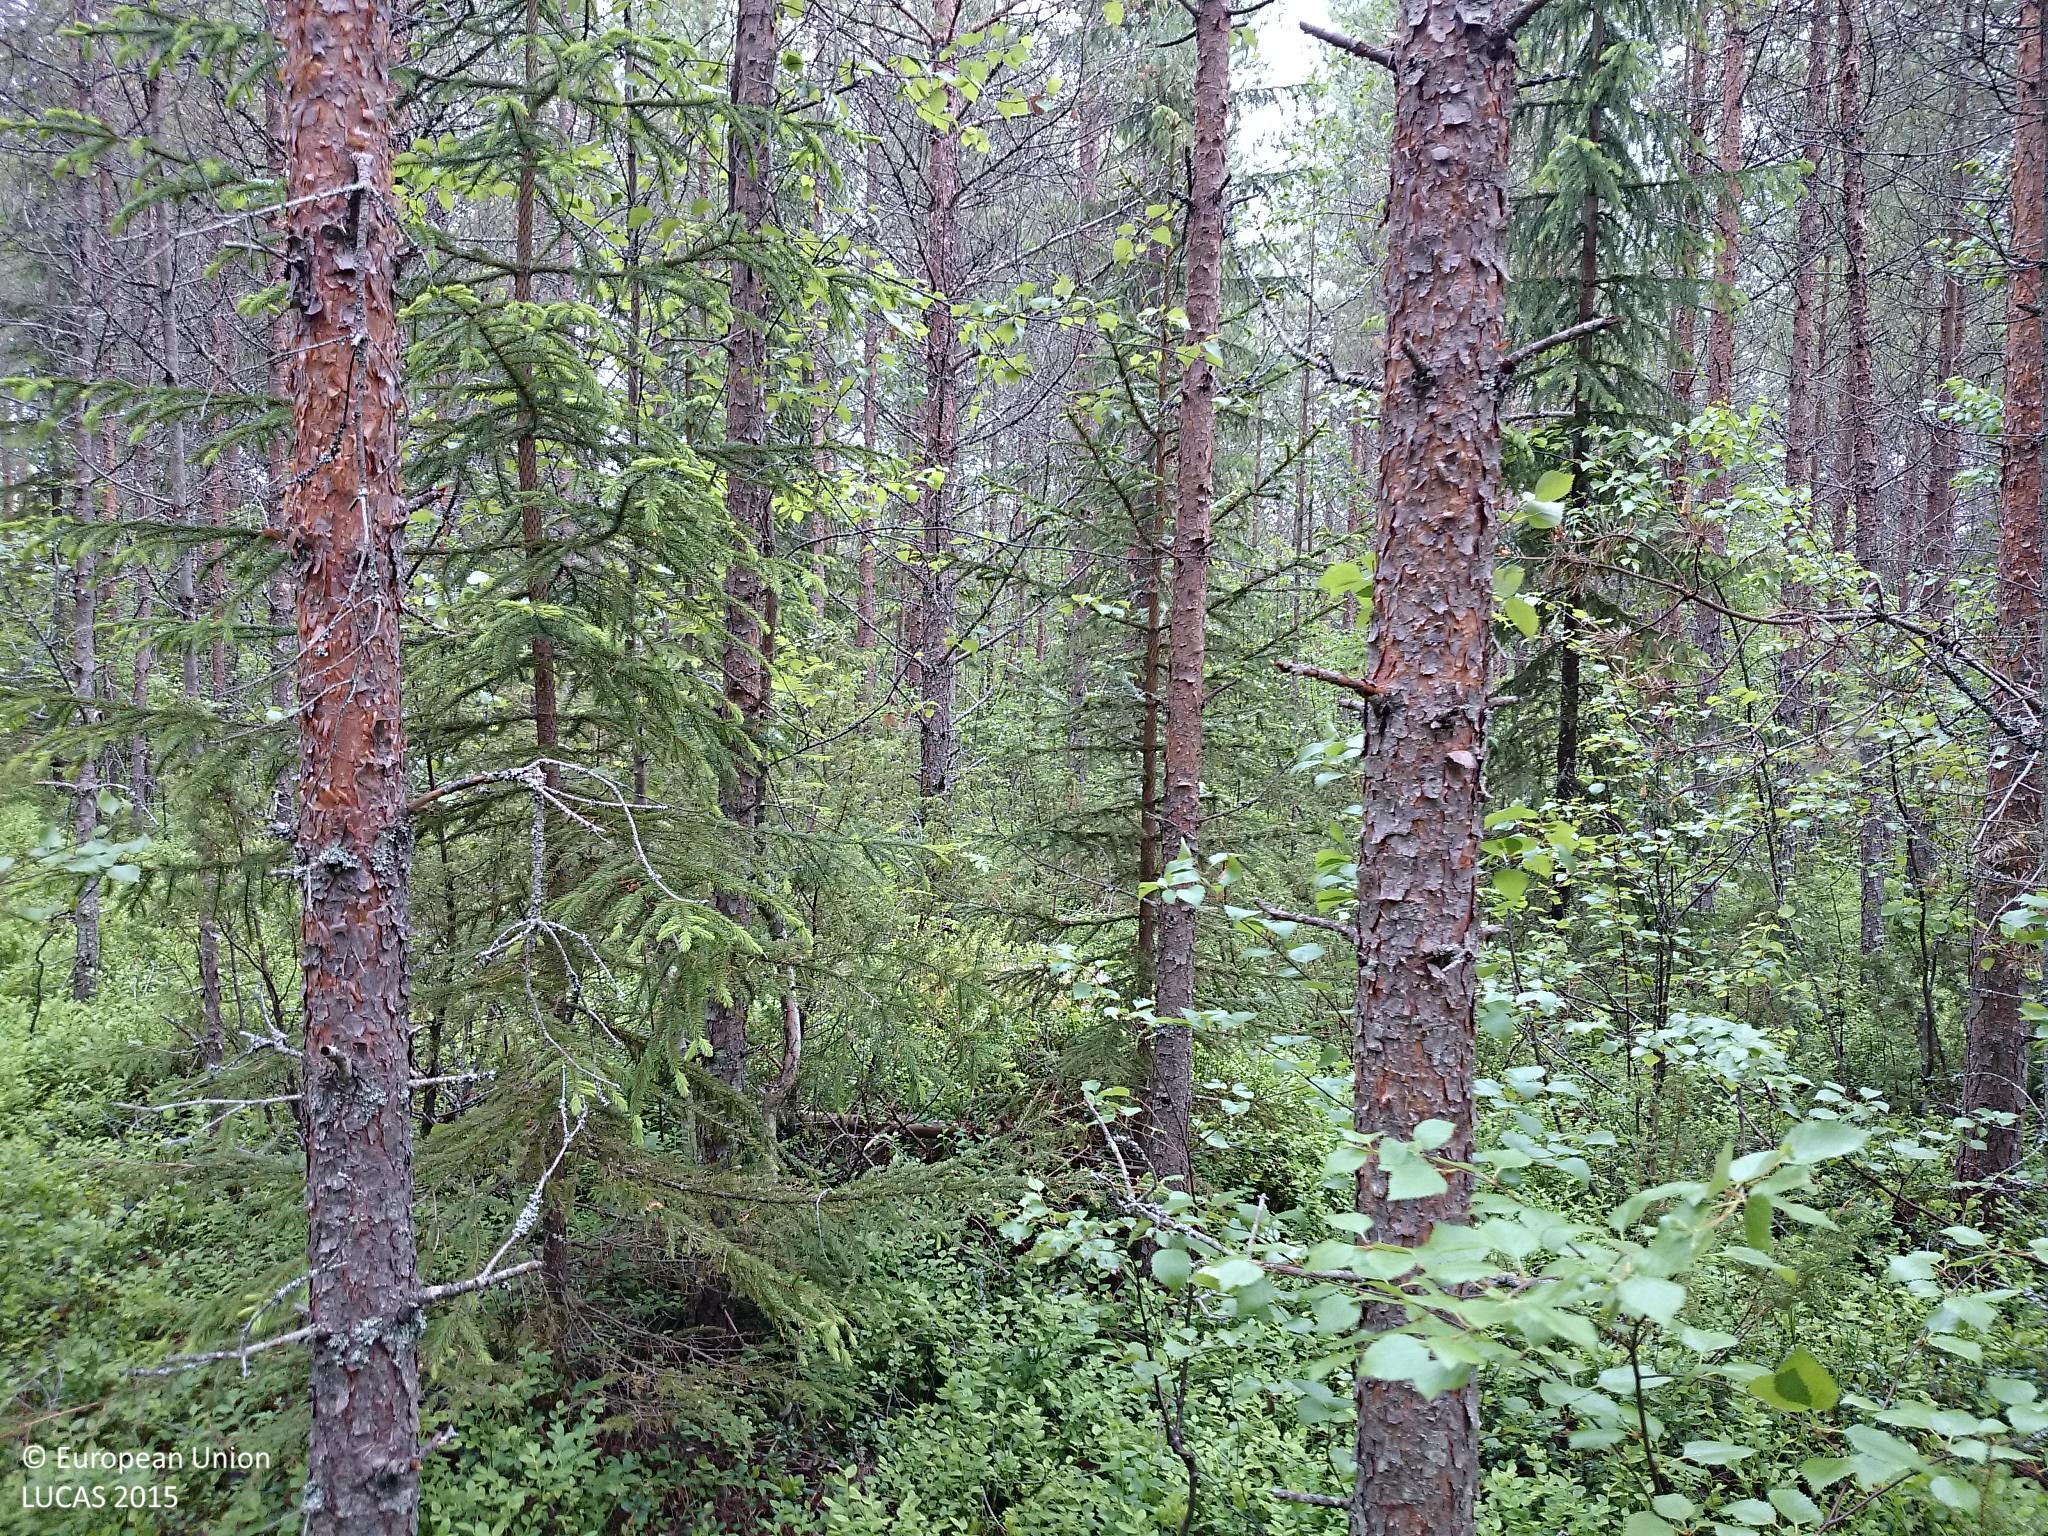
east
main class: Woodland
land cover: Pine dominated mixed woodland
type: boreal forest
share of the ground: > 75 %
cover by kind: coniferous forest trees 60 %, broadleaved forest trees 20 %, shrubs 20 %
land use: Forestry
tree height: > 5 m
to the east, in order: Pine dominated mixed woodland; Grass margins; Ditches and canals; Paved roads, cycling and walking lanes; Ditches and canals; Shrubland without tree cover; Pine dominated mixed woodland; Ditches and canals; Pine dominated mixed woodland; Other coniferous woodland; Other mixed woodland
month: June
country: SE
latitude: 64.1404
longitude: 20.7708
